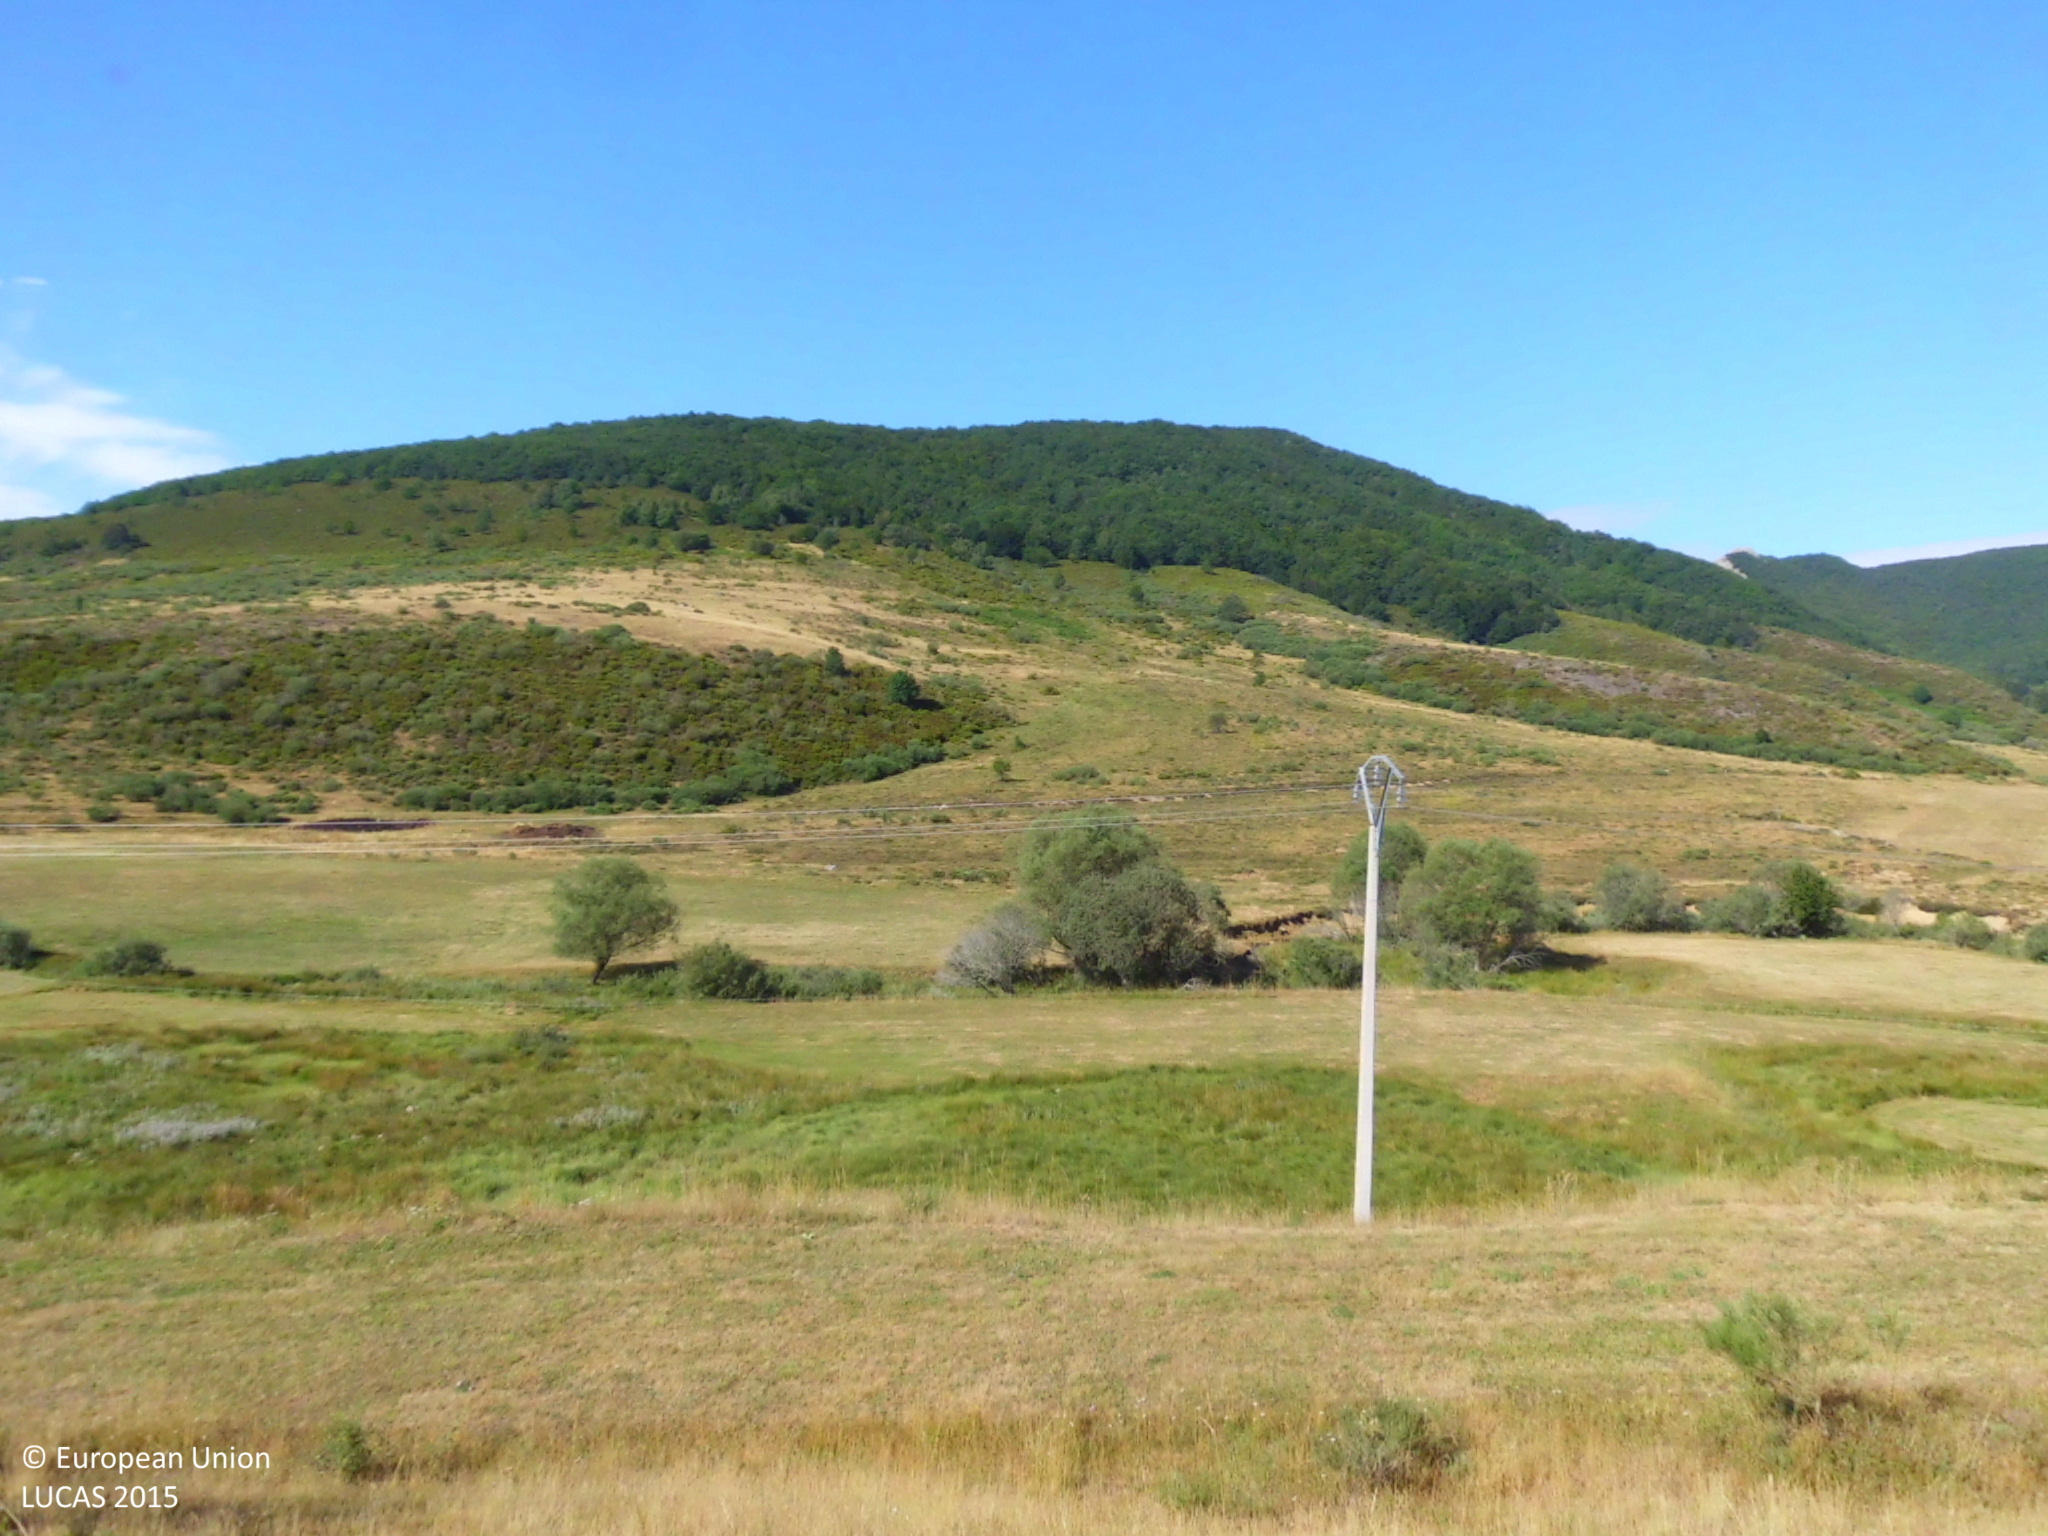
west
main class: Shrubland
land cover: Shrubland with sparse tree cover
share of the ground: > 75 %
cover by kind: shrubs 90 %, broadleaved forest trees 5 %, herbaceous plants 5 %
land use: Semi-natural and natural areas not in use
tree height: < 5 m
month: July
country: ES
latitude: 43.0148
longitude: -4.4980
